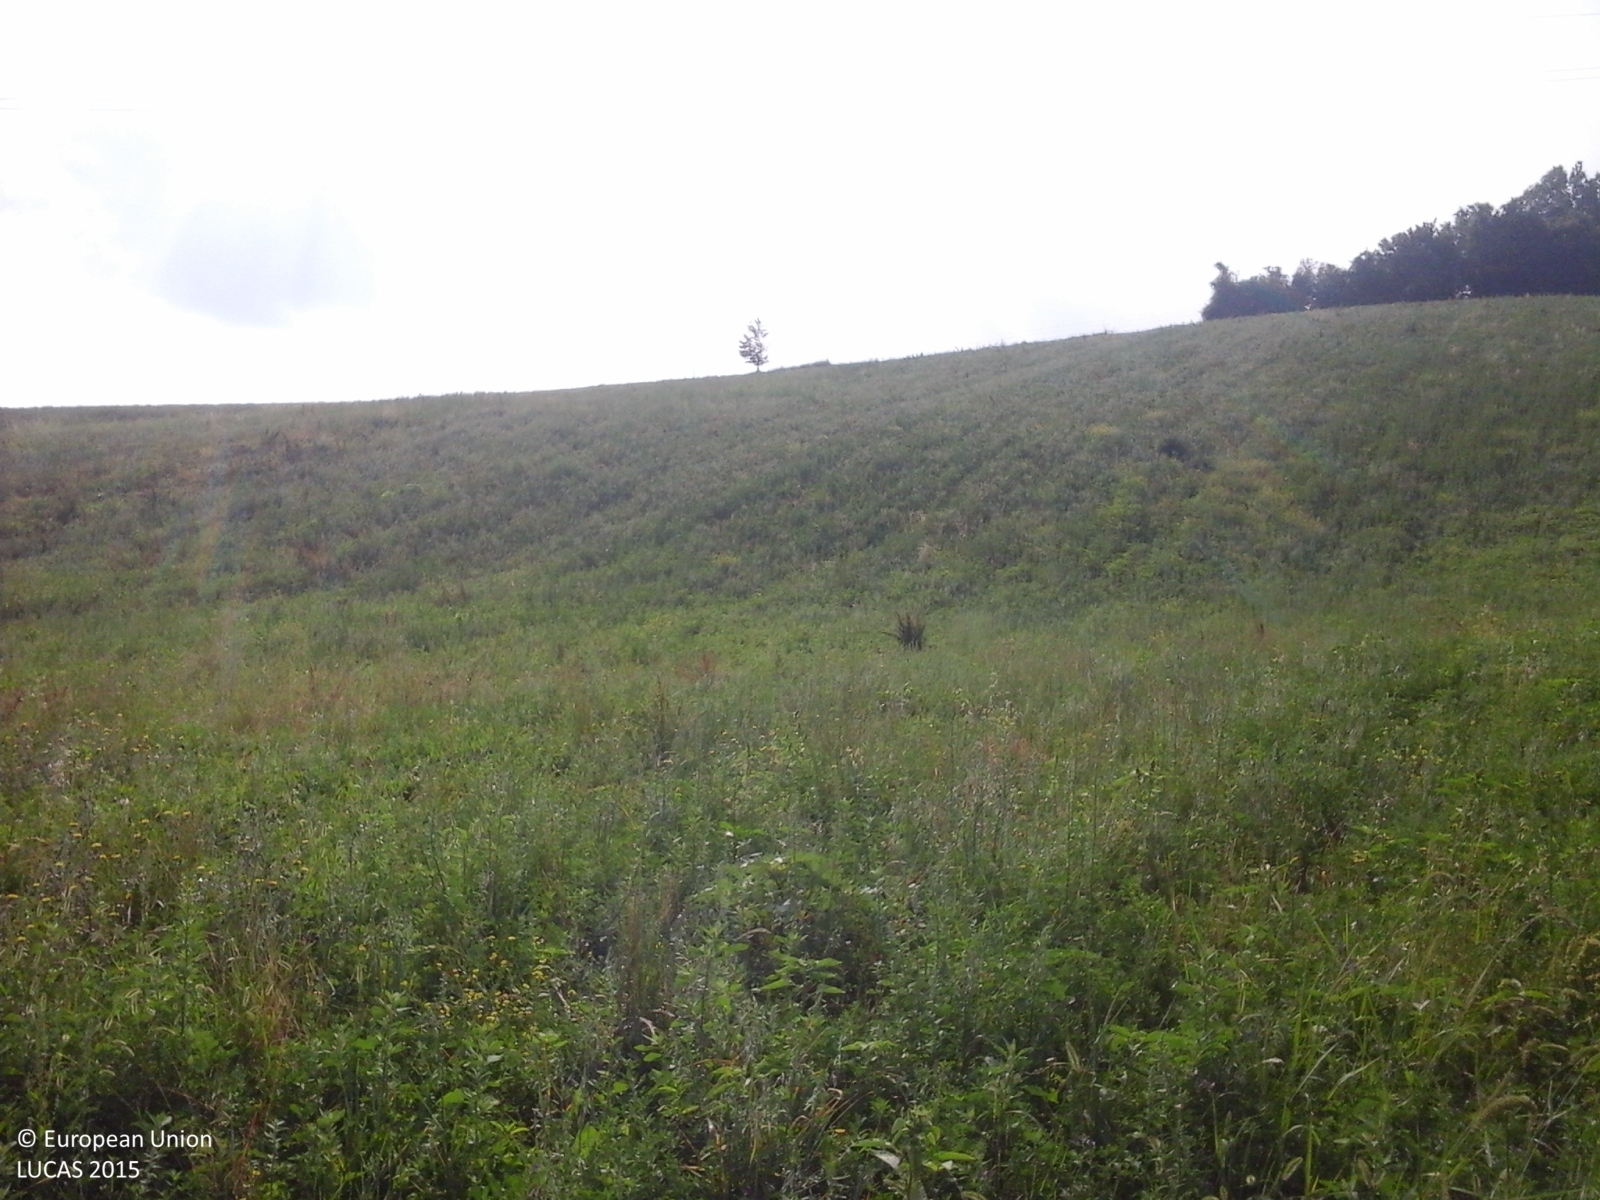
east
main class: Cropland
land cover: Lucerne
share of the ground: > 75 %
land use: Agriculture (excluding fallow land and kitchen gardens)
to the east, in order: Lucerne; Ditches and canals; Tracks; Lucerne; Electric lines; Lucerne; Fences; Grassland without tree/shrub cover
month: June
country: IT
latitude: 44.6387
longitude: 10.2893
